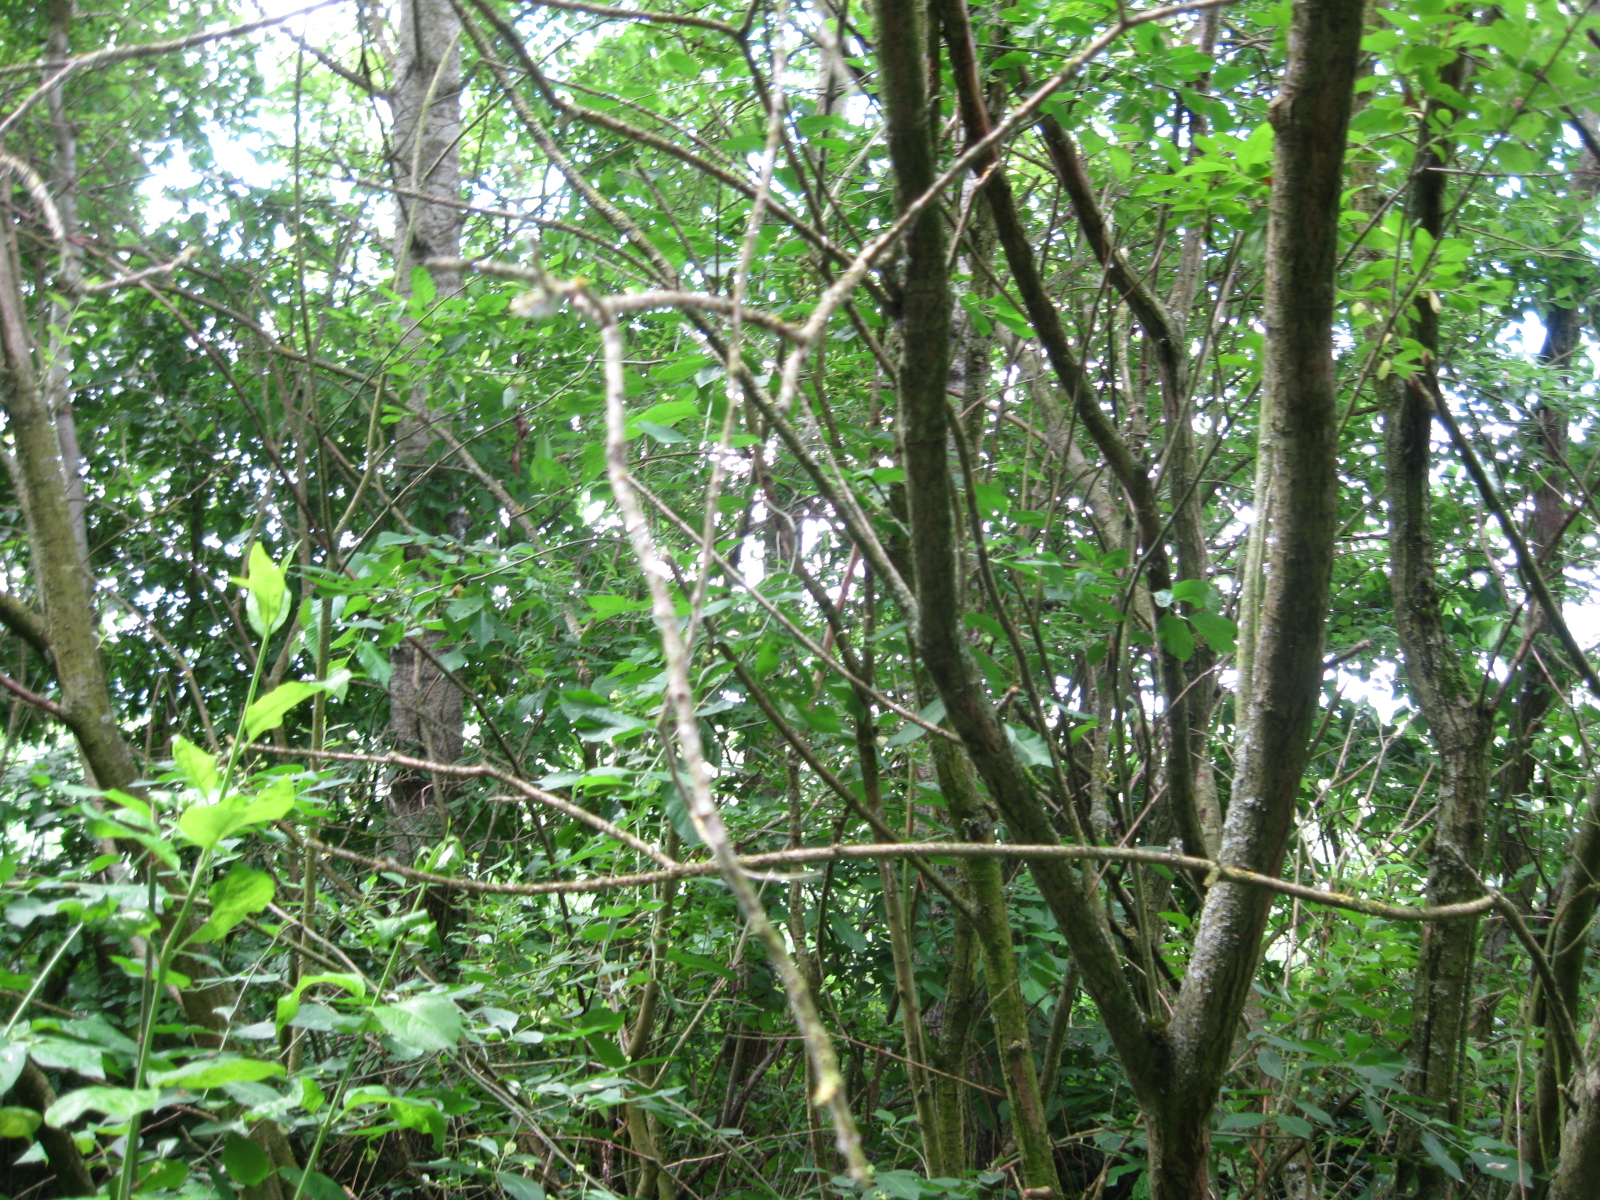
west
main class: Woodland
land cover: Broadleaved woodland
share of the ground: > 75 %
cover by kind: broadleaved forest trees 80 %, herbaceous plants 10 %, coniferous forest trees 5 %, shrubs 5 %
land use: Forestry
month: June
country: LT
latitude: 55.2914
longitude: 24.1235
